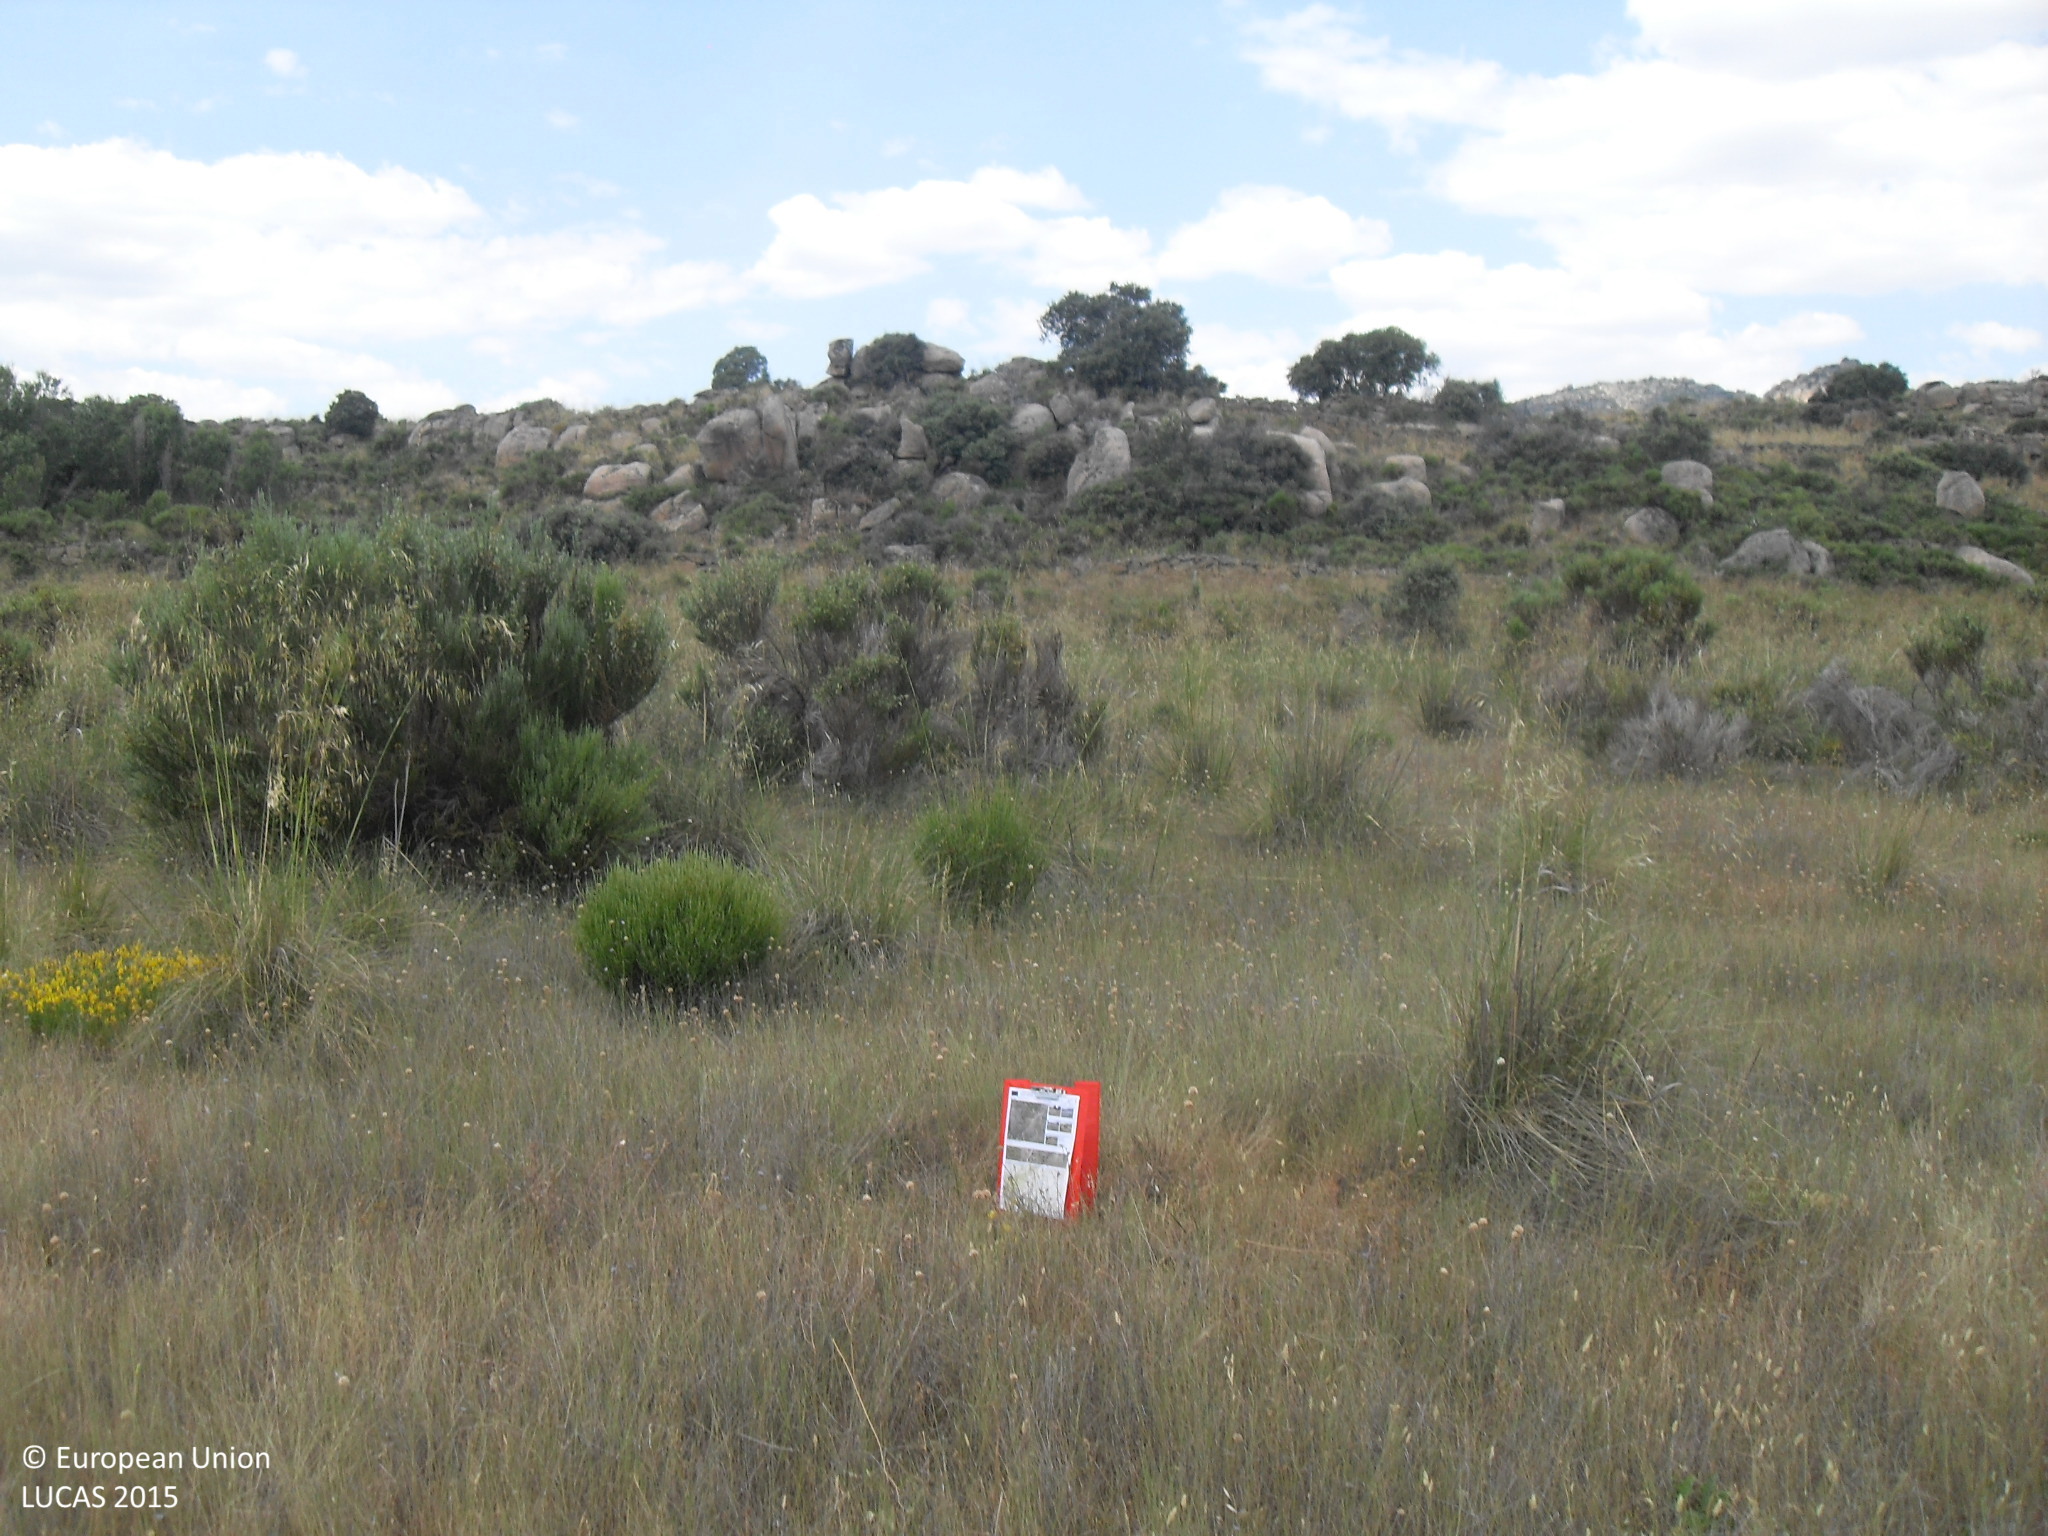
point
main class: Grassland
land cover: Grassland without tree/shrub cover
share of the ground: > 75 %
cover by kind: herbaceous plants 100 %
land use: Agriculture (excluding fallow land and kitchen gardens)
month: June
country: ES
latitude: 40.4565
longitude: -5.5267
